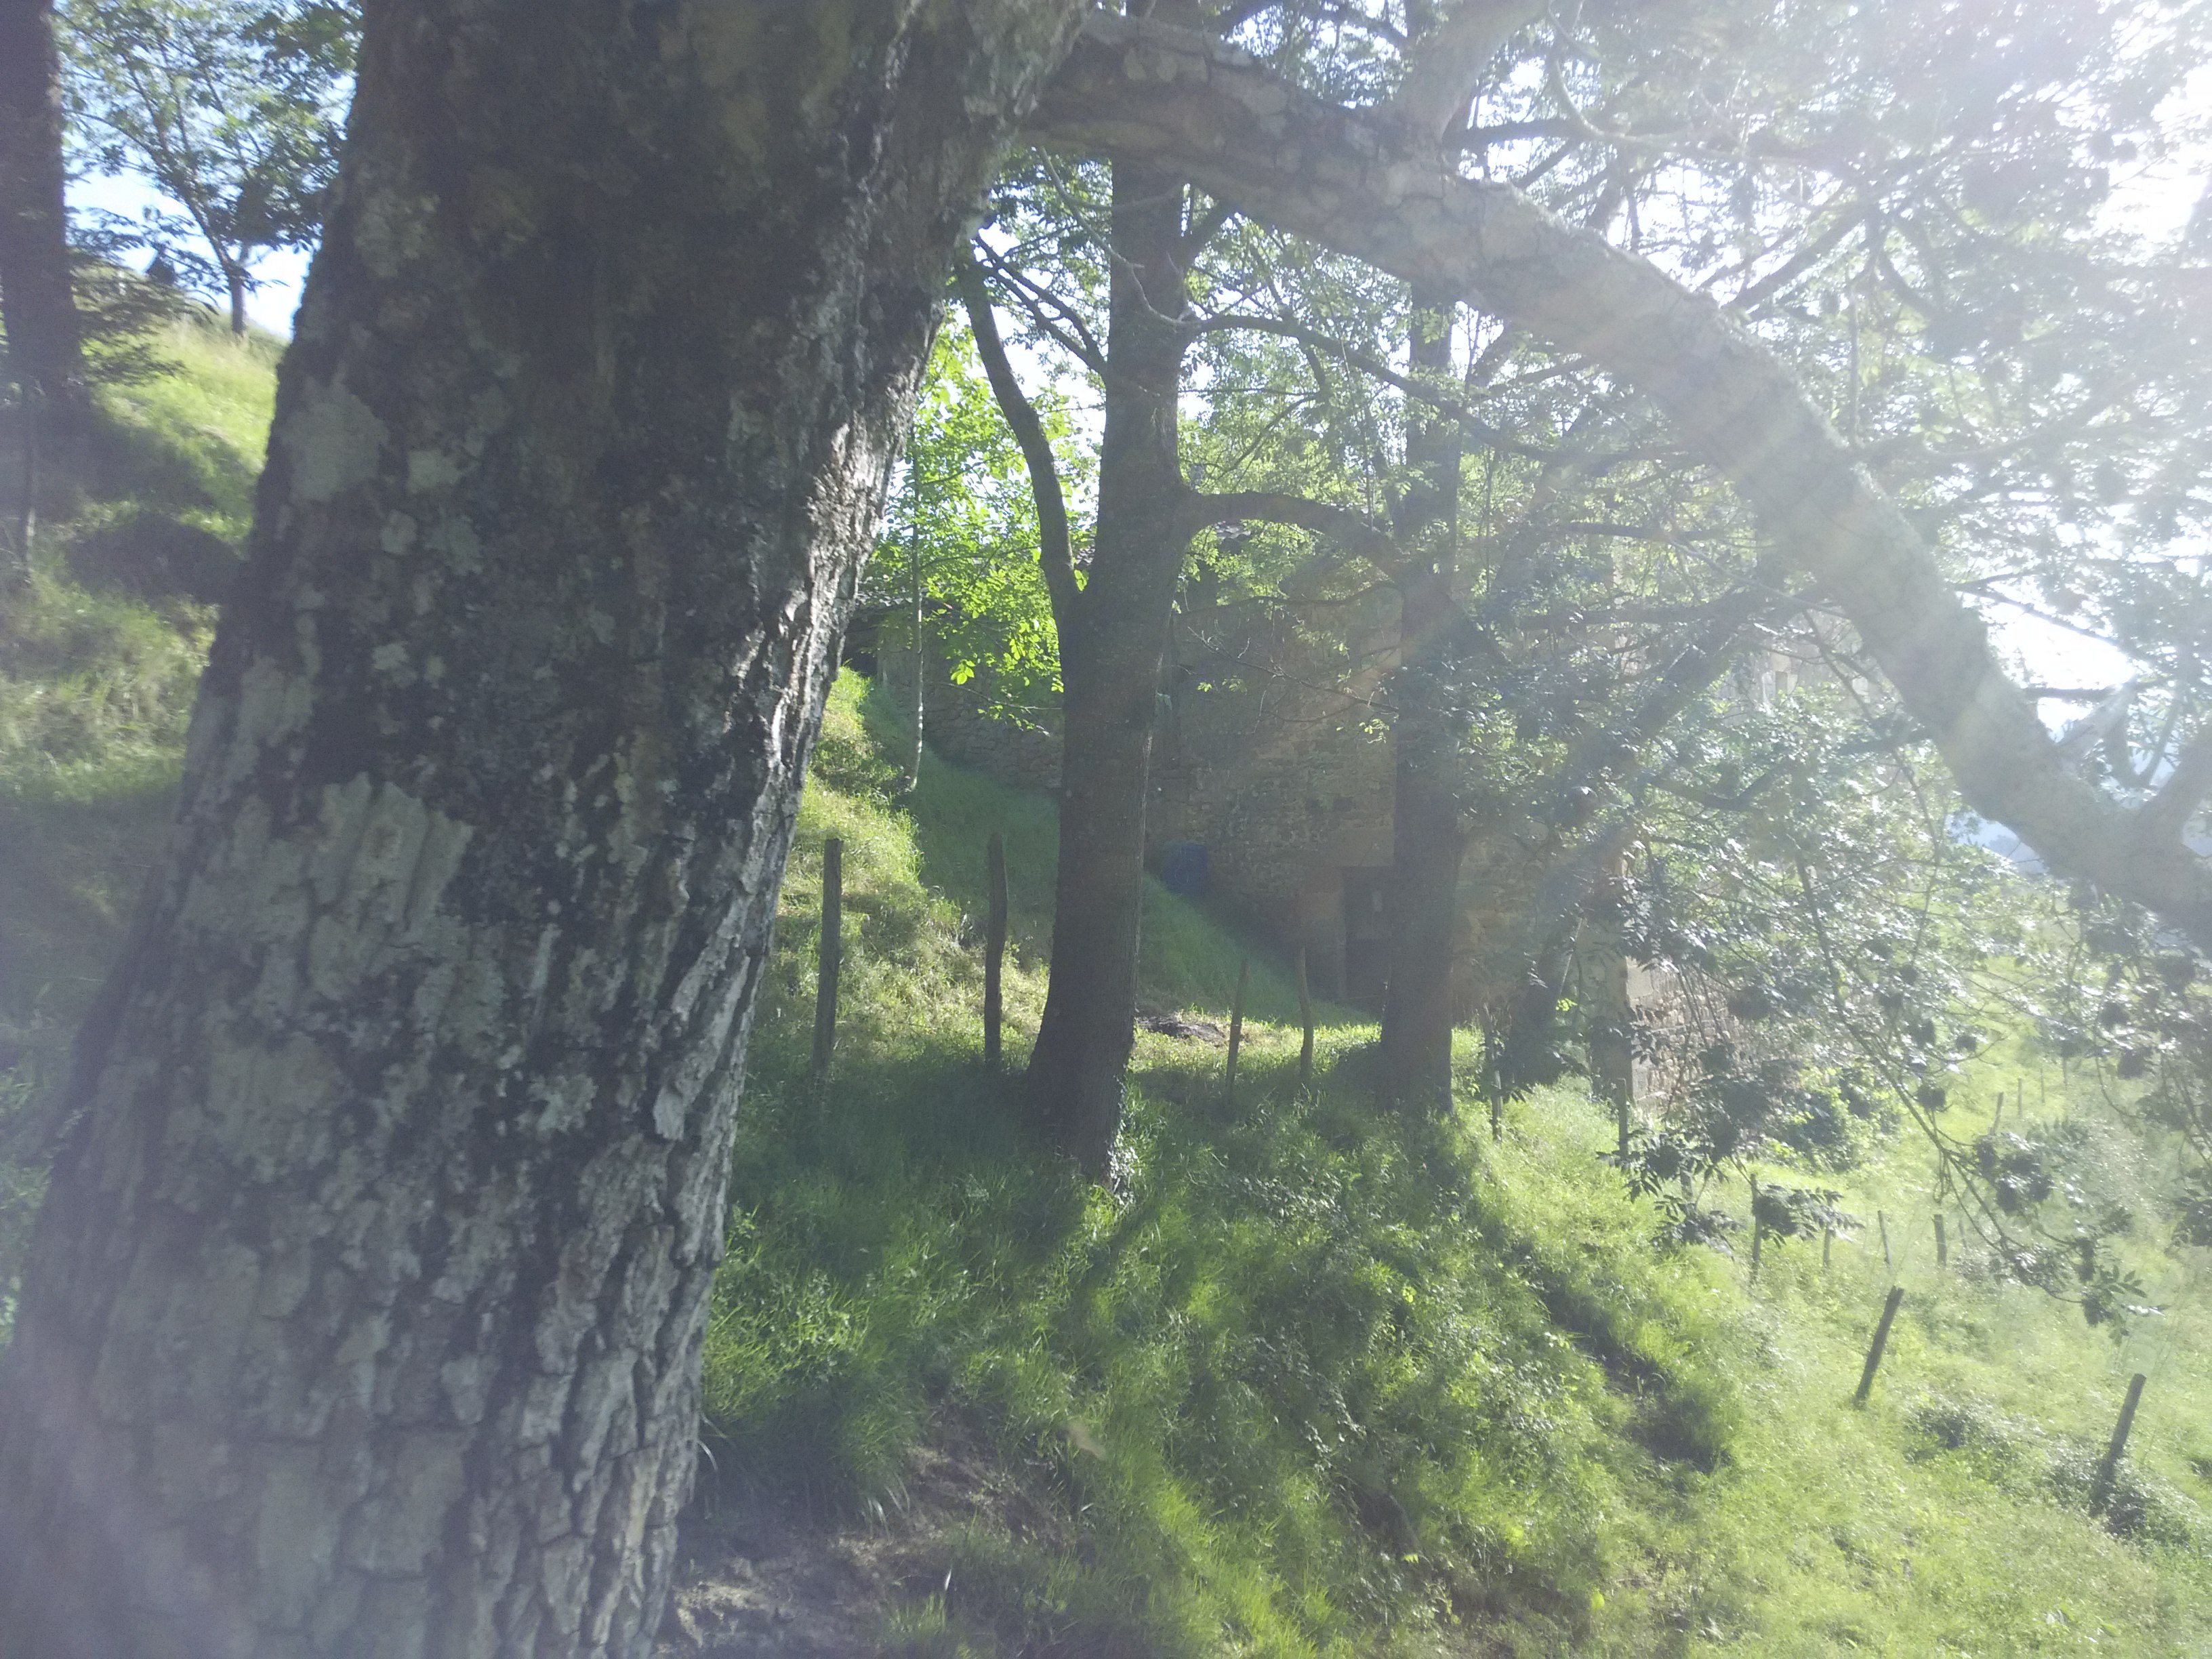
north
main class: Woodland
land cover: Broadleaved woodland
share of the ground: > 75 %
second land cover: Grassland without tree/shrub cover
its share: 10 - 25 %
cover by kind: broadleaved forest trees 70 %, herbaceous plants 20 %, coniferous forest trees 10 %
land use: Forestry
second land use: Agriculture (excluding fallow land and kitchen gardens)
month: July
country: ES
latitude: 42.9778
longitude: -2.2979
